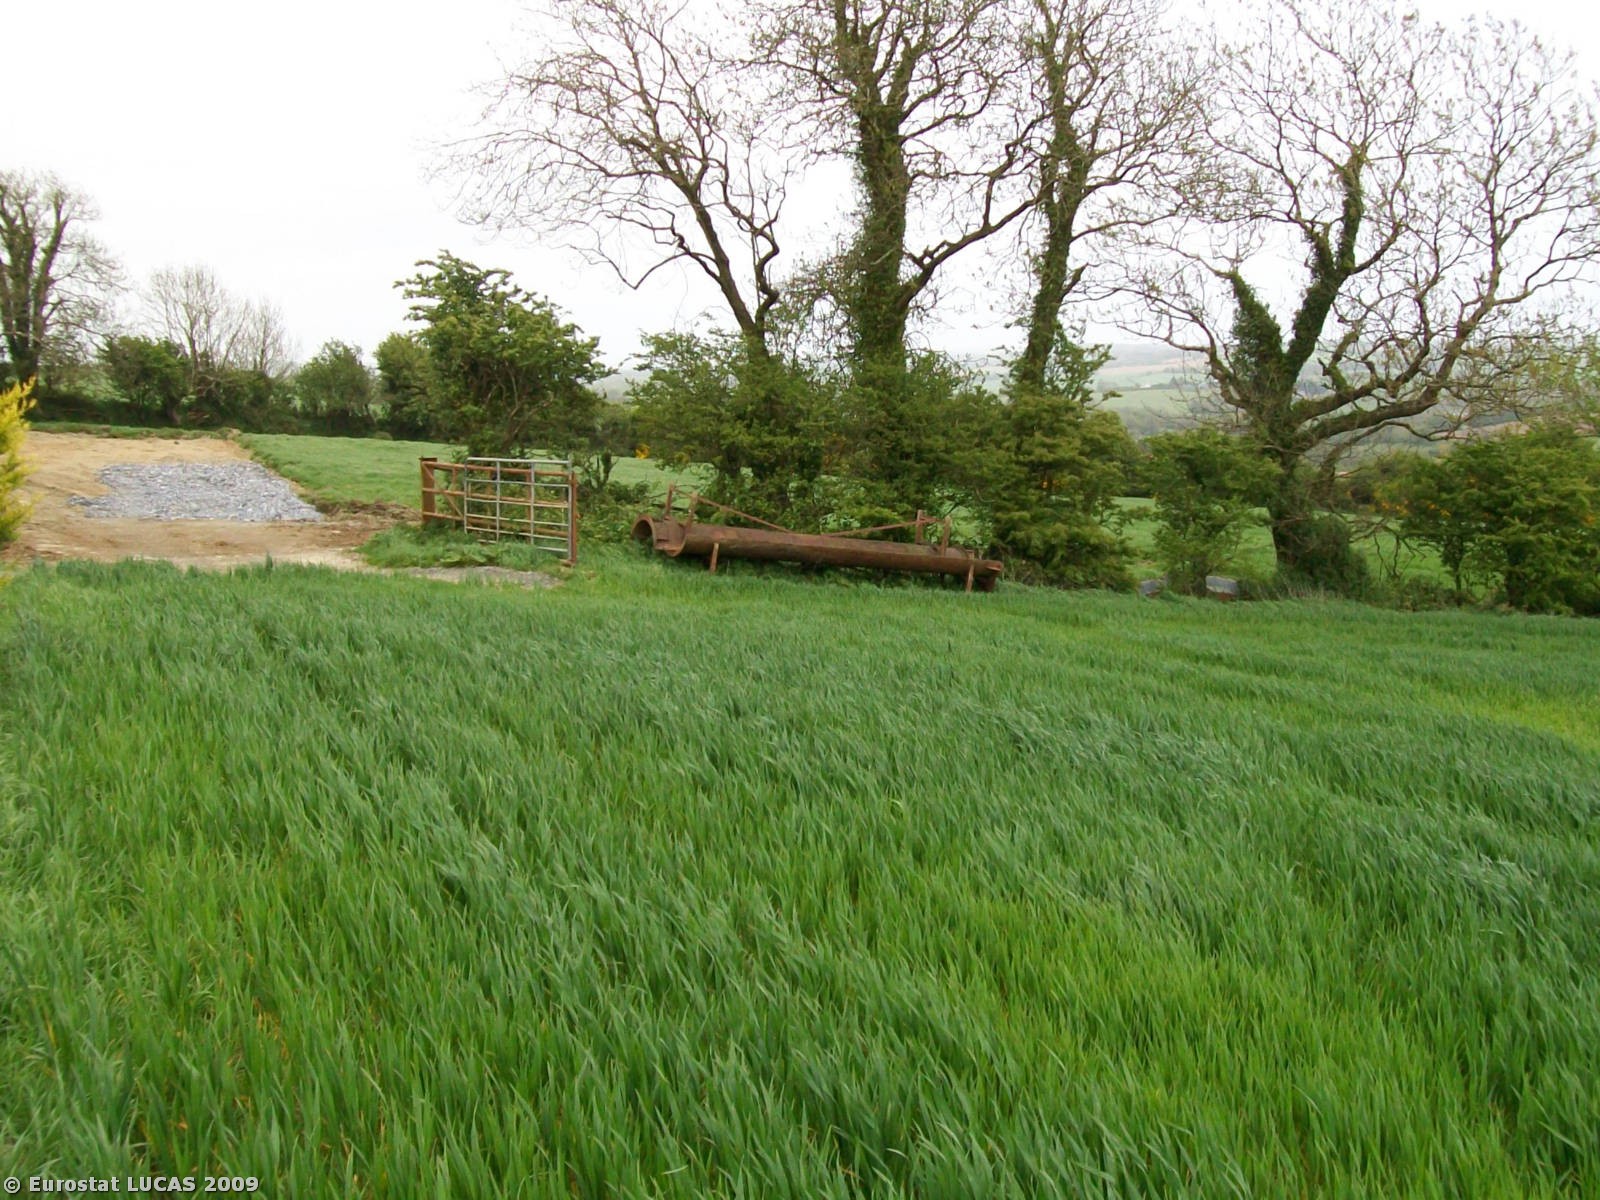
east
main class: Cropland
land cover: Common wheat
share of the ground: > 75 %
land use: Agriculture (excluding fallow land and kitchen gardens)
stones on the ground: < 10 %
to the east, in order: Common wheat; Grass margins; Rivers and streams; Abandoned hedges; Grassland without tree/shrub cover; Abandoned hedges; Fences; Grassland without tree/shrub cover
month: May
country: IE
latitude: 51.7110
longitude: -8.6522
